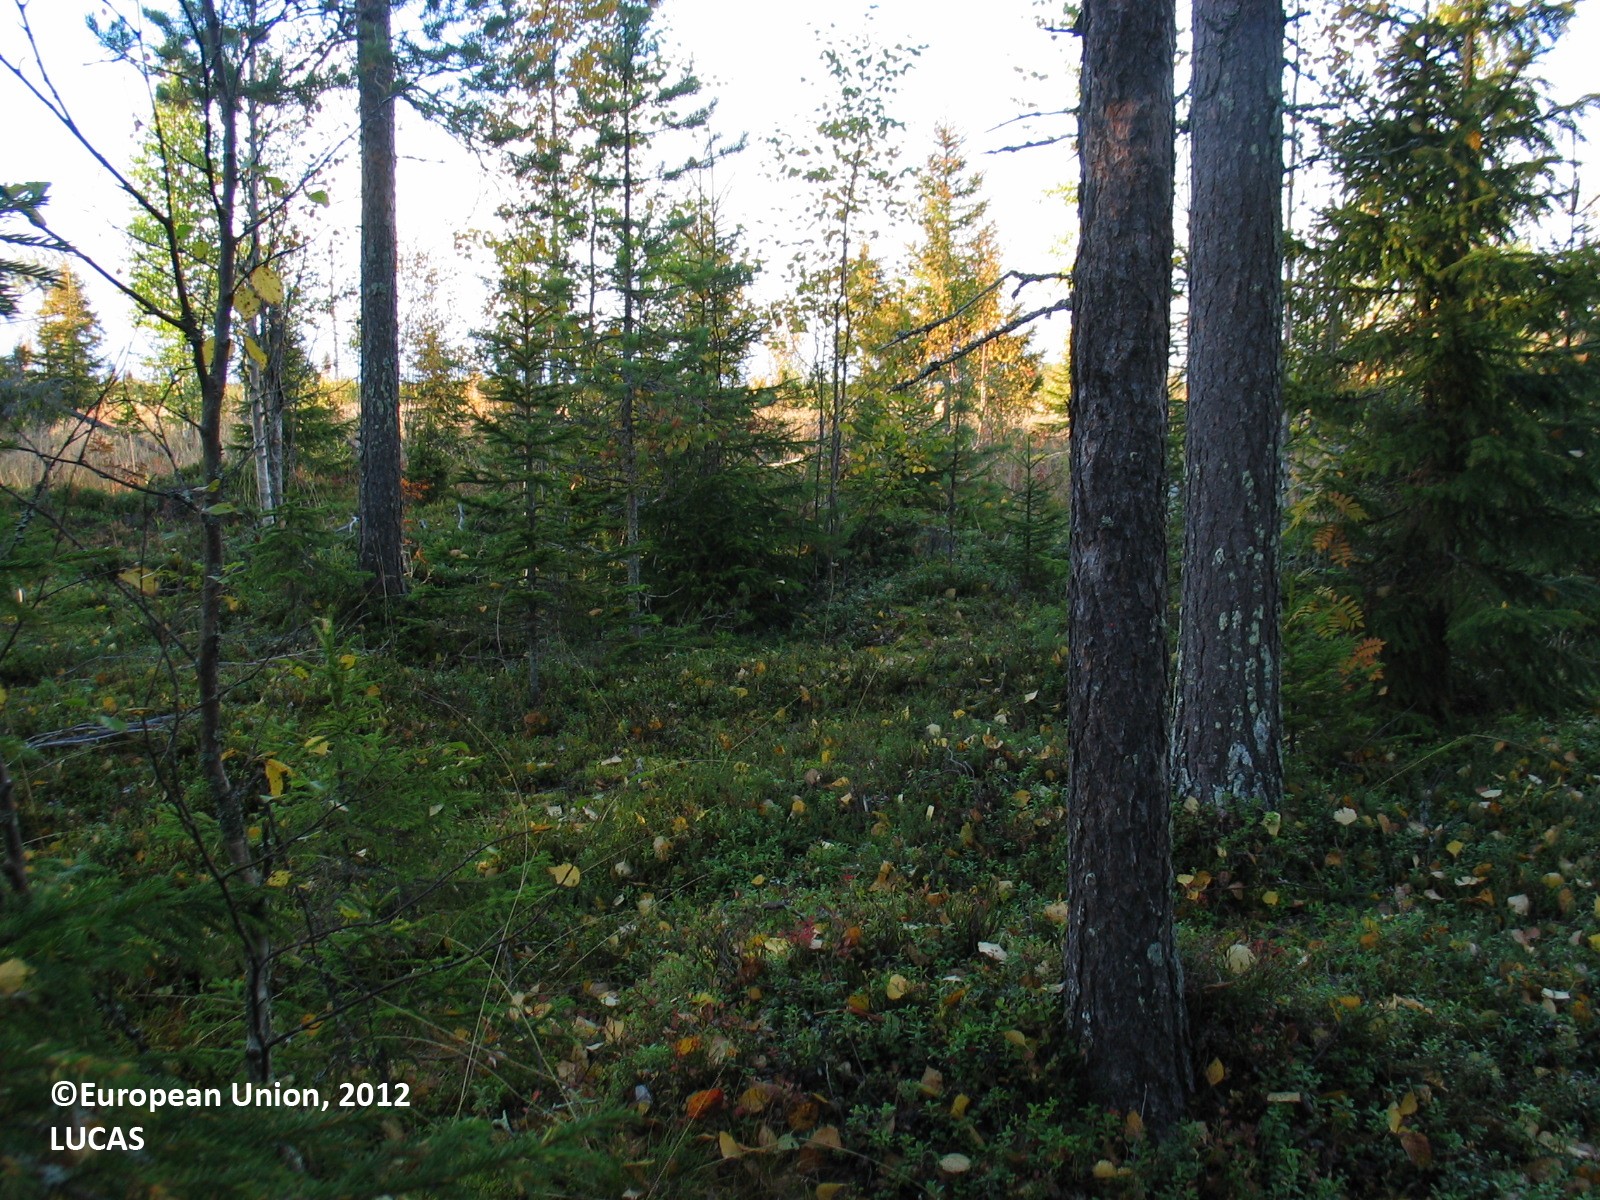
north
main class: Woodland
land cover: Other mixed woodland
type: boreal forest
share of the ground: 50 - 75 %
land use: Forestry
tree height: > 5 m
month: September
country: FI
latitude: 65.5321
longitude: 25.7262
